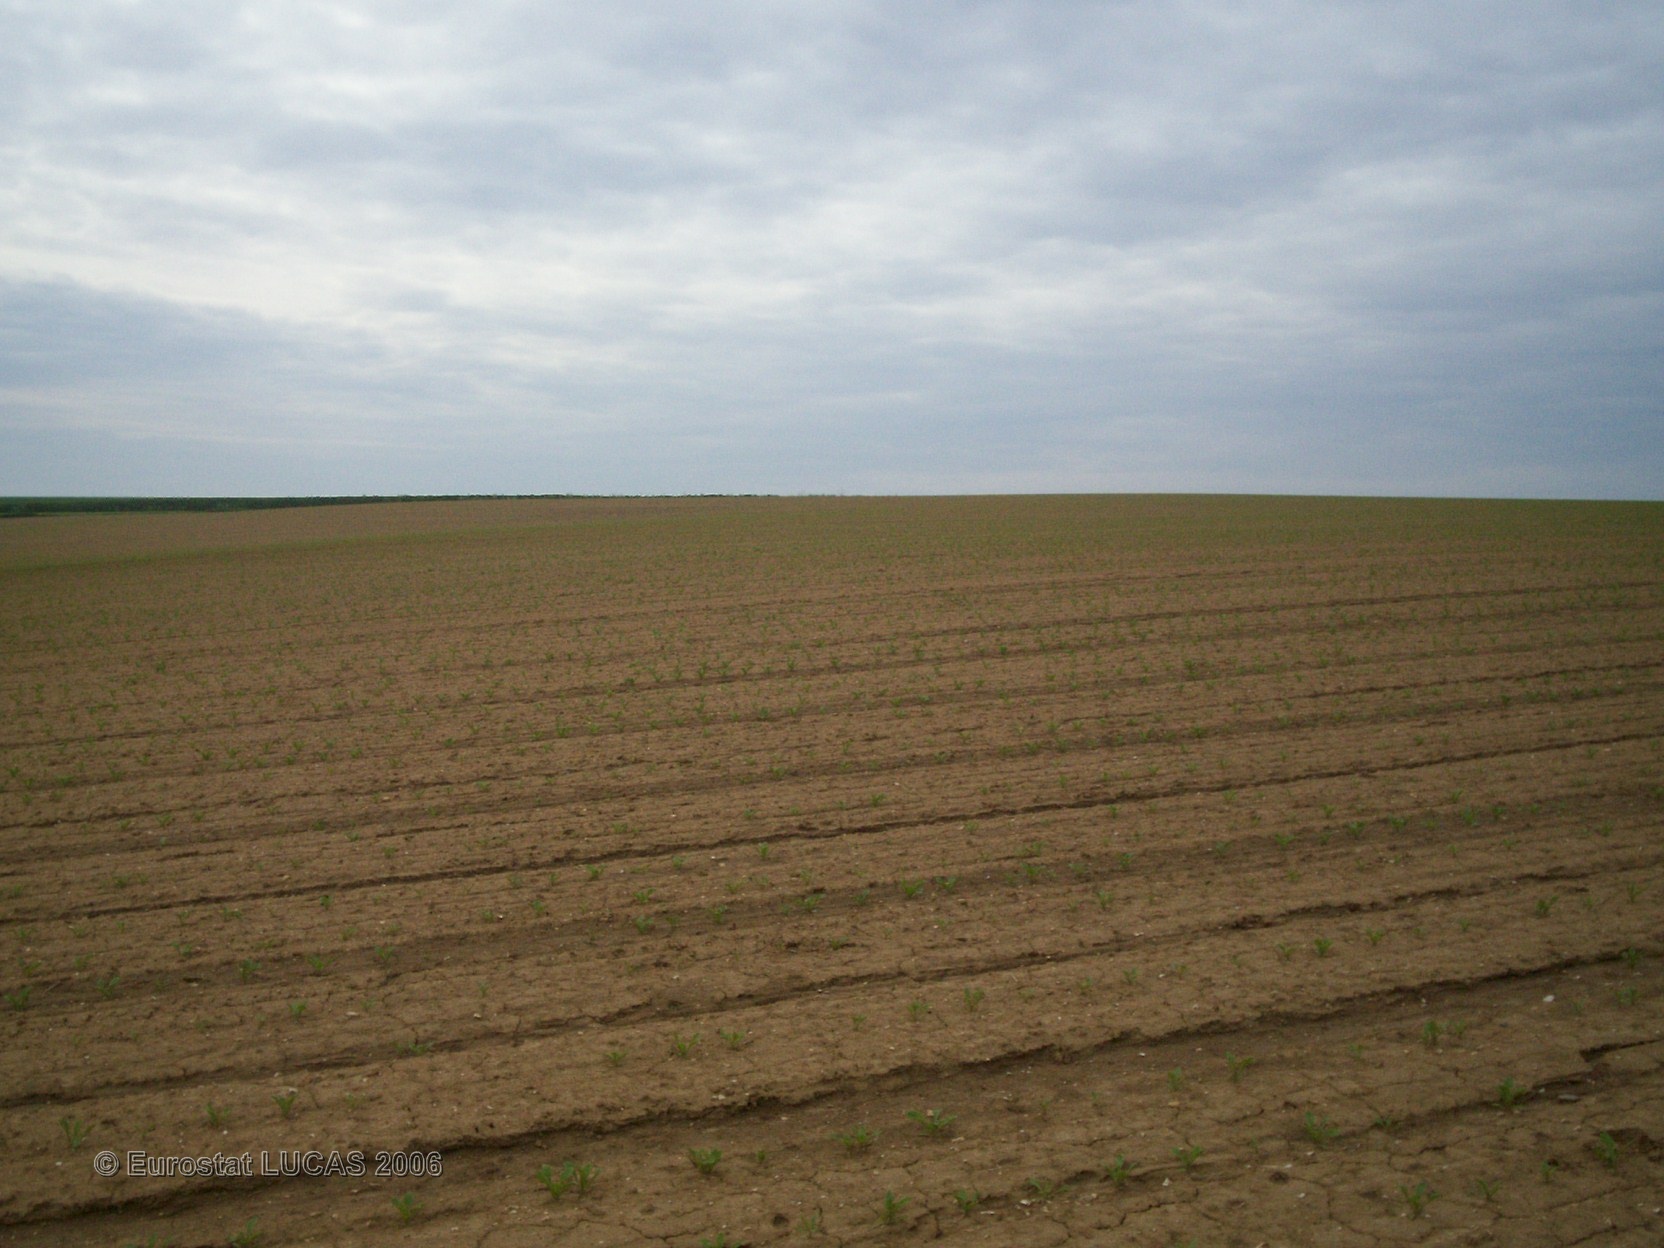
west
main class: Cropland
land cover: Sugar beet
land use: Agriculture (excluding fallow land and kitchen gardens)
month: May
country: FR
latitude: 49.8621
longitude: 3.6357
